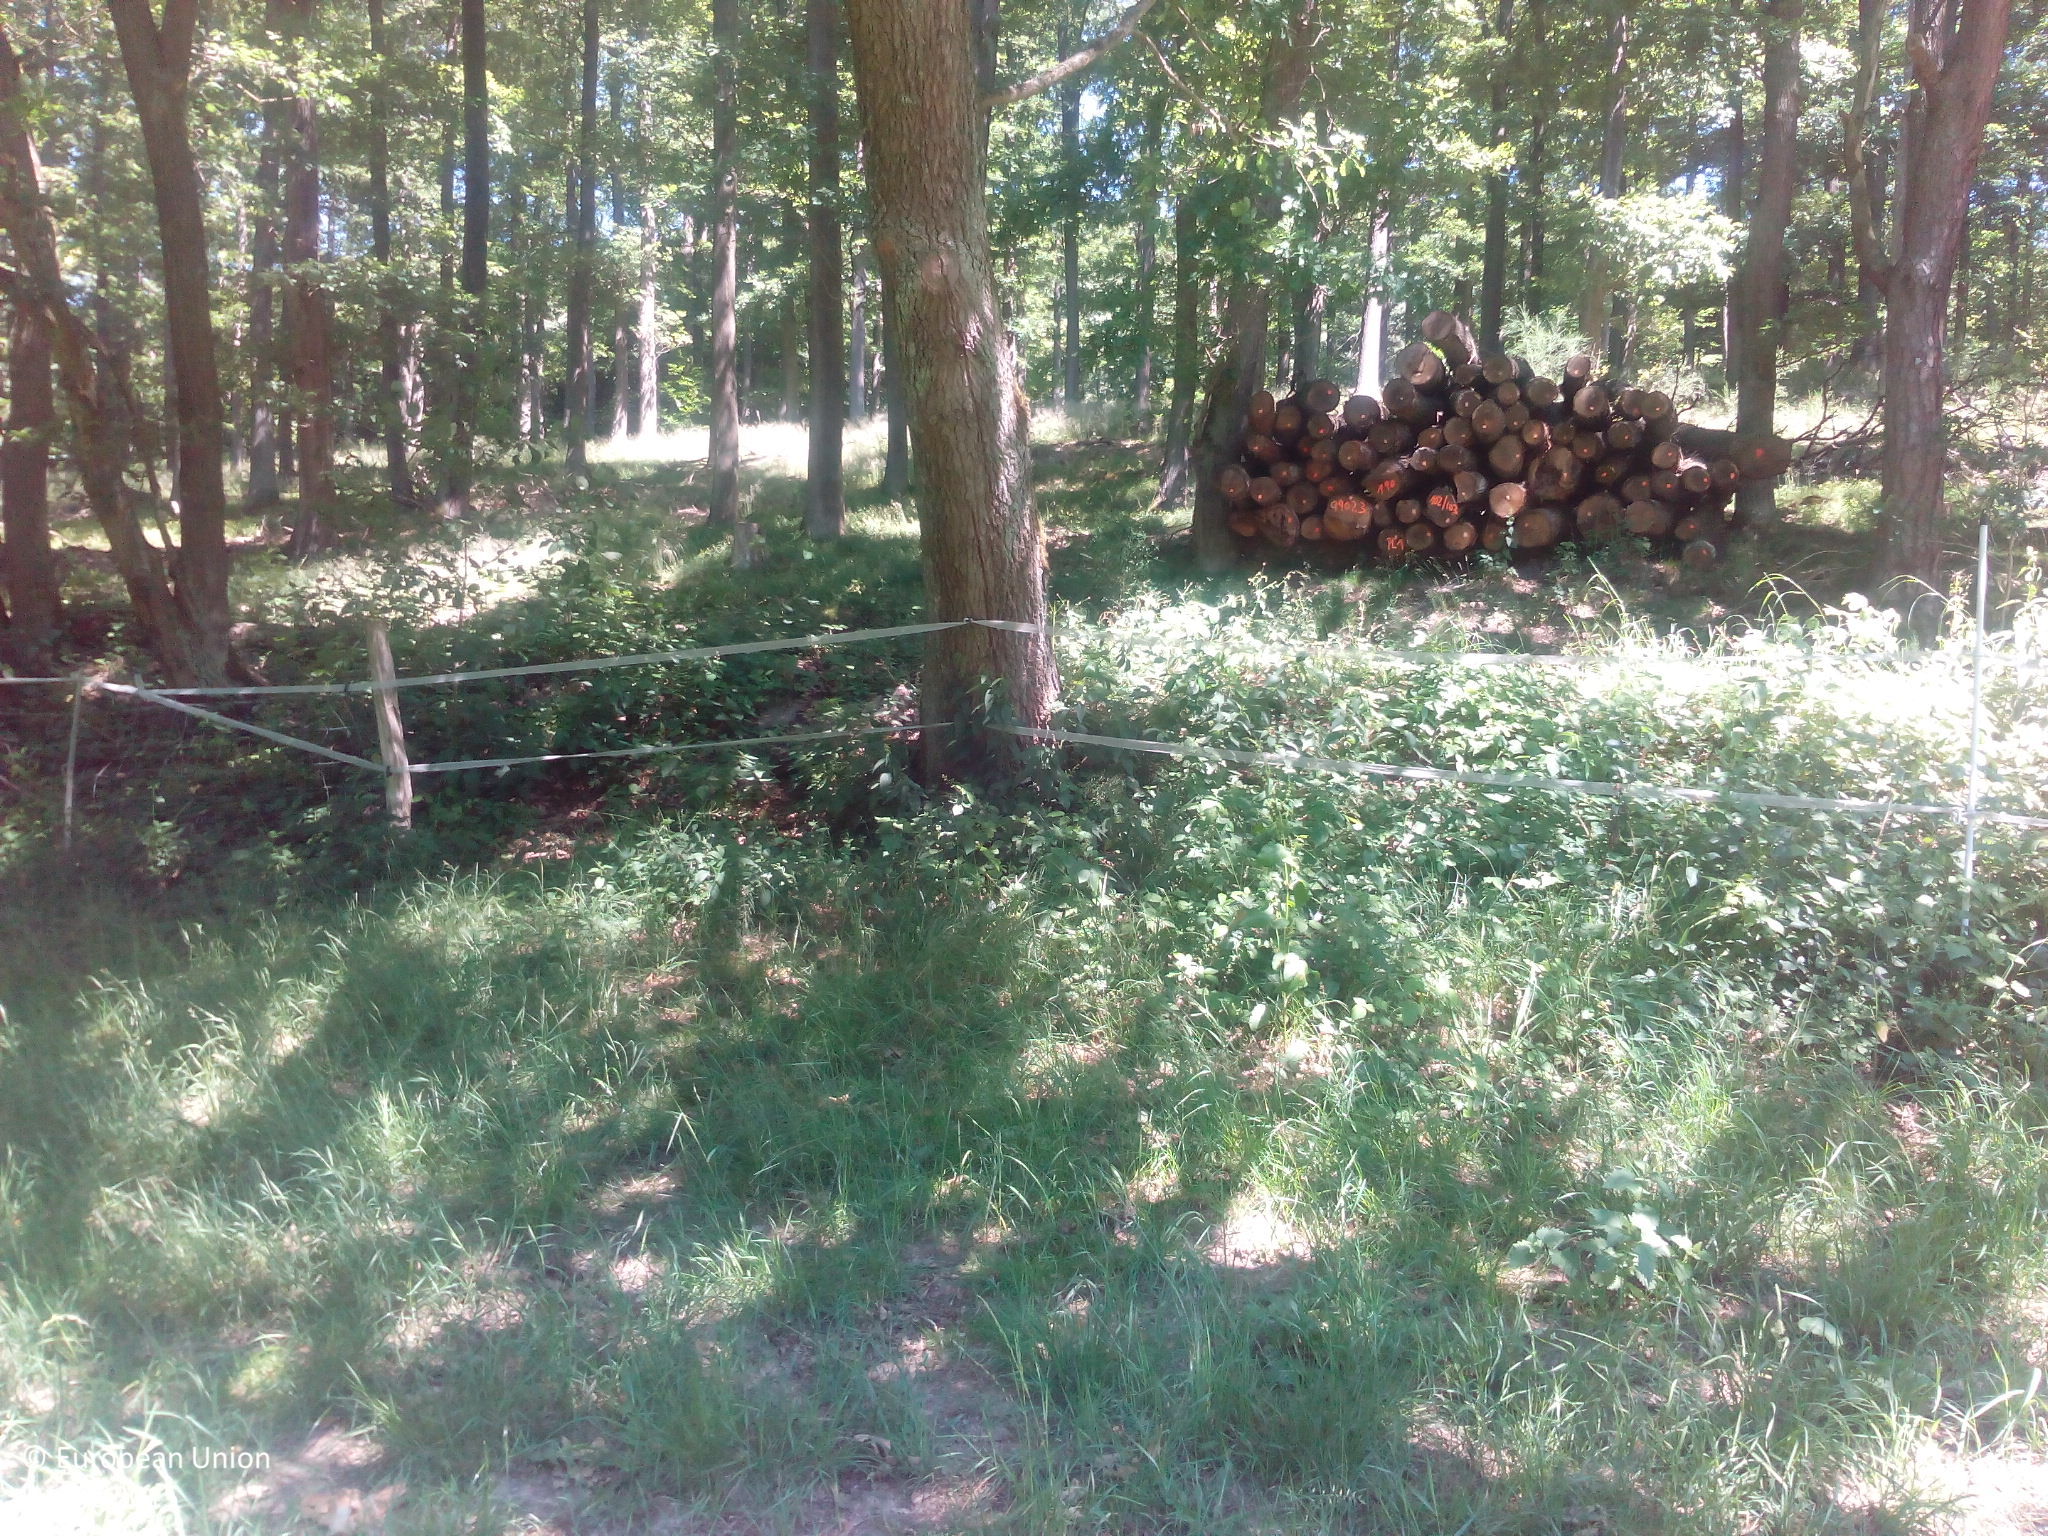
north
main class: Grassland
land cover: Grassland without tree/shrub cover
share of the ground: 50 - 75 %
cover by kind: herbaceous plants 60 %, unconsolidated bare surface 40 %
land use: Agriculture (excluding fallow land and kitchen gardens)
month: June
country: DE
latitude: 50.2819
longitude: 8.4707
